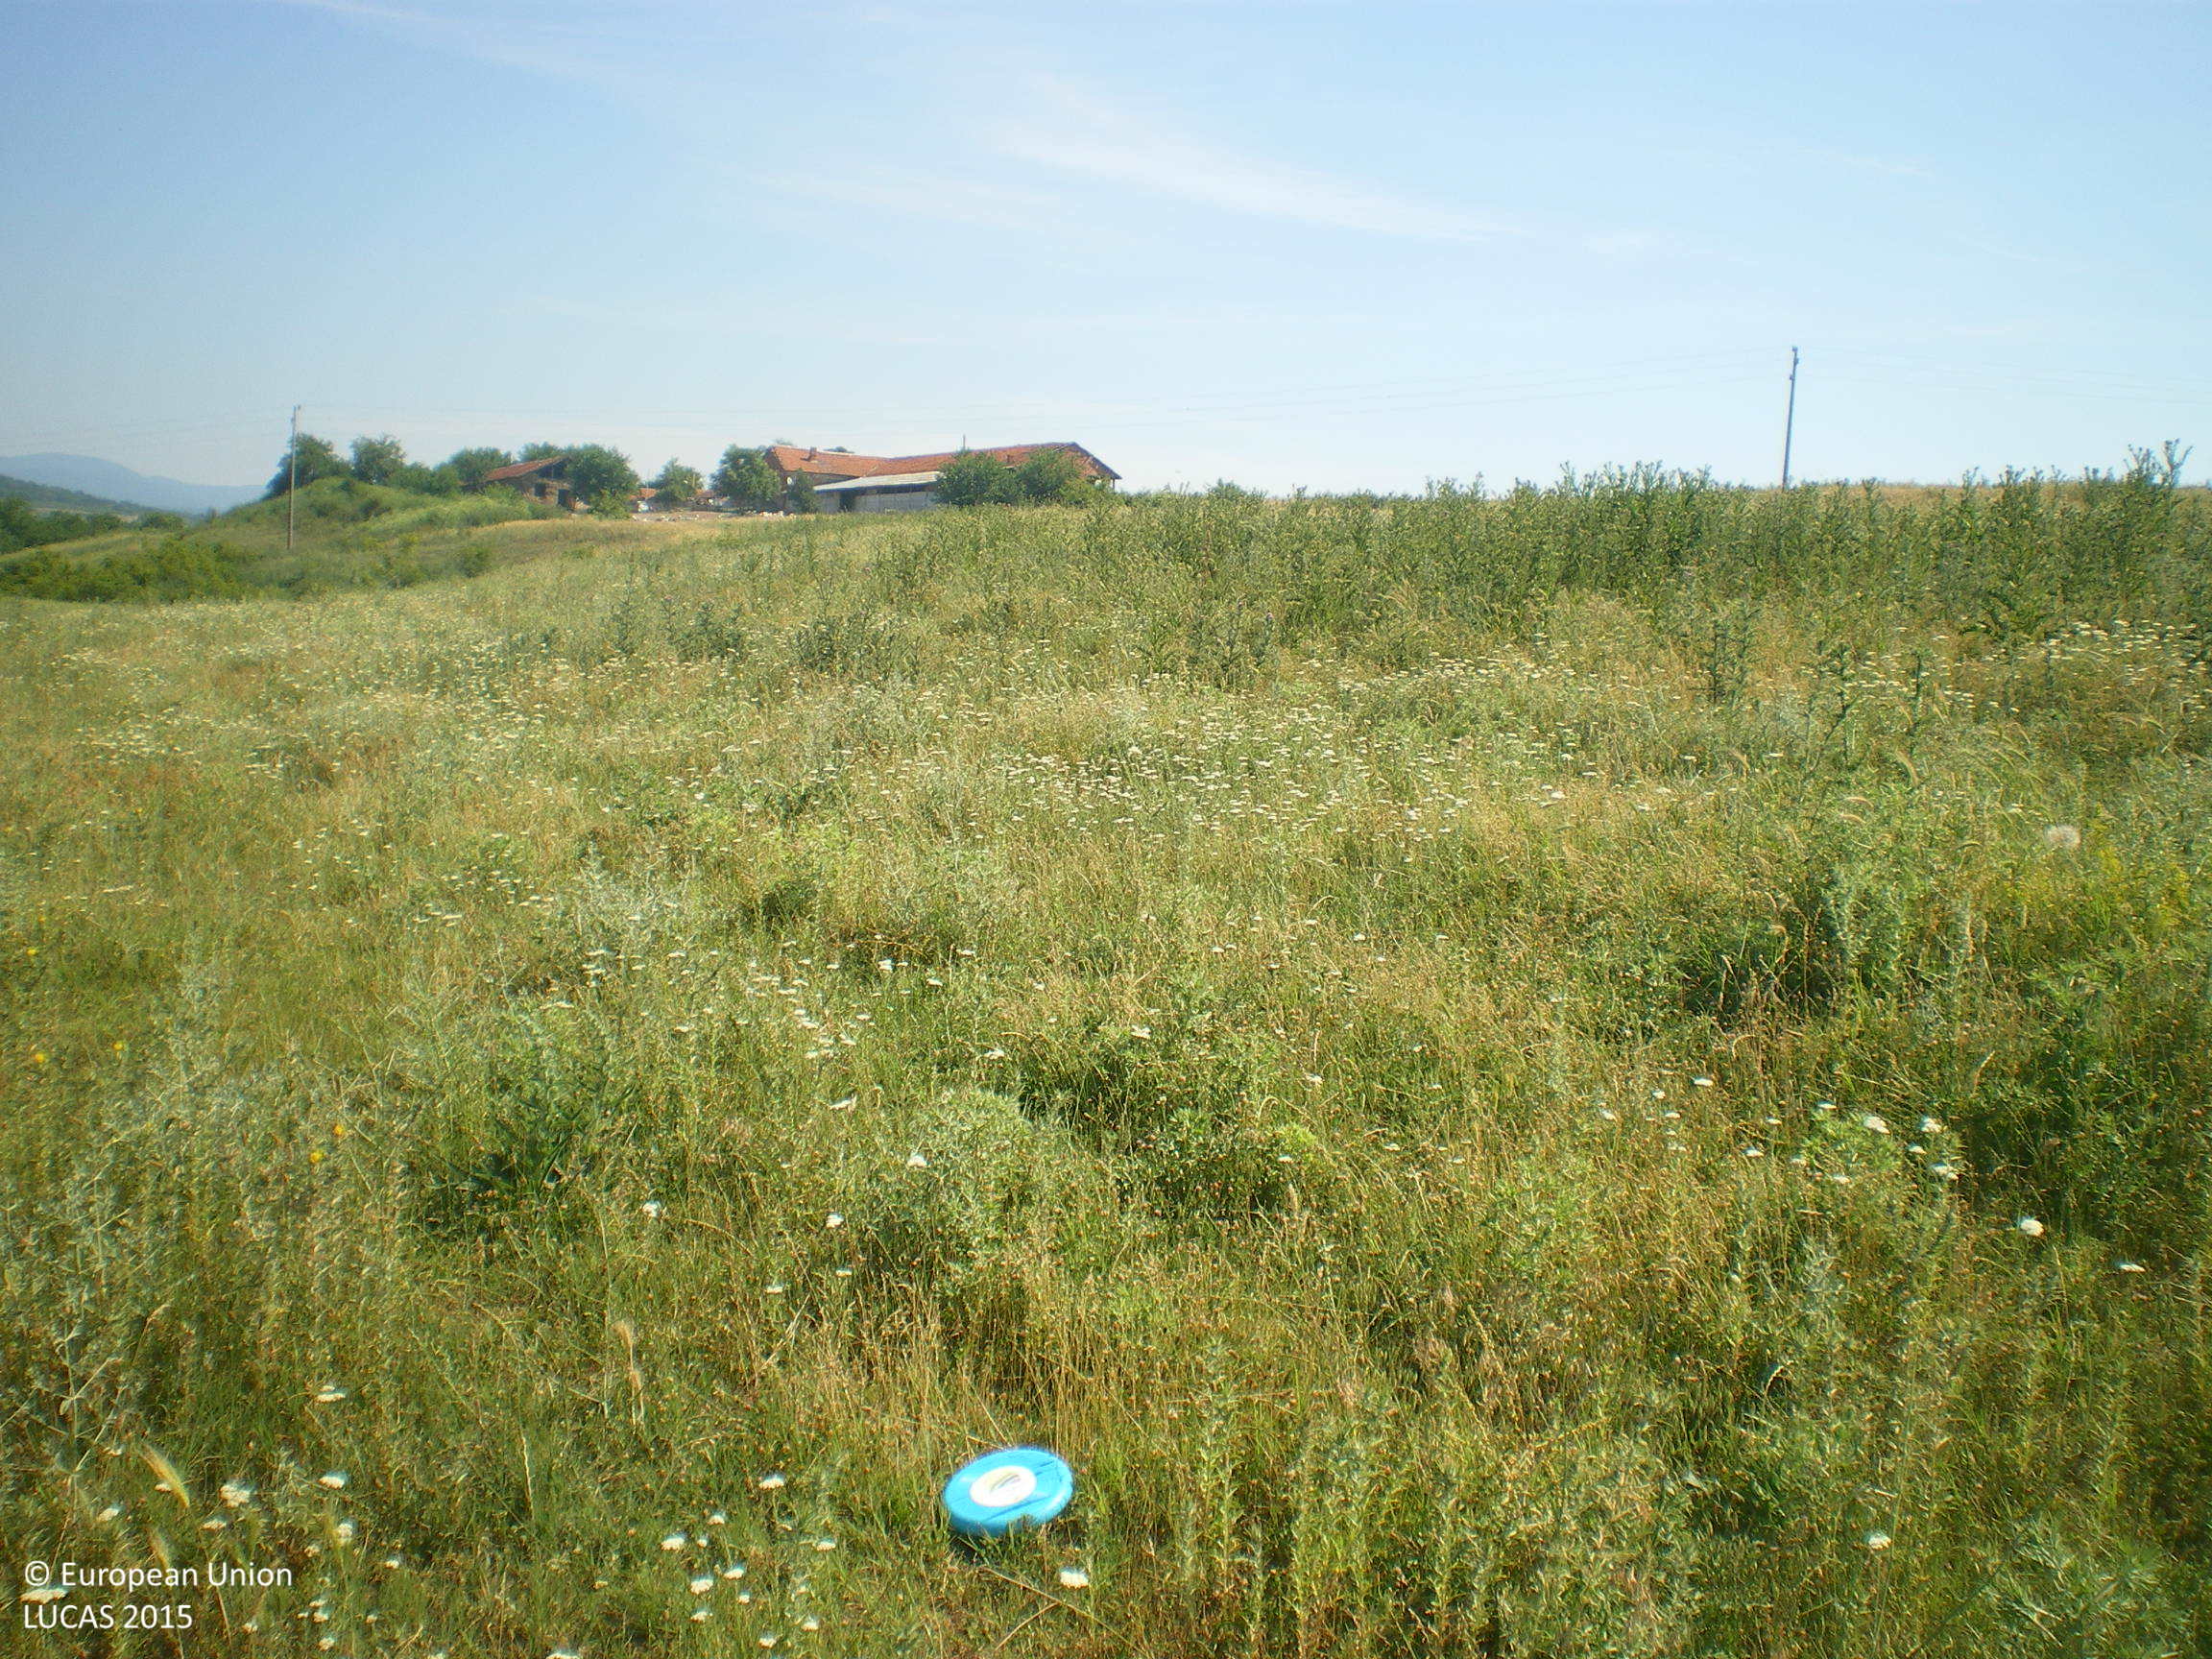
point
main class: Grassland
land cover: Spontaneously vegetated surfaces
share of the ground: > 75 %
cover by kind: herbaceous plants 100 %
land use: Fallow land
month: June
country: BG
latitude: 42.3327
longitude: 25.1464
